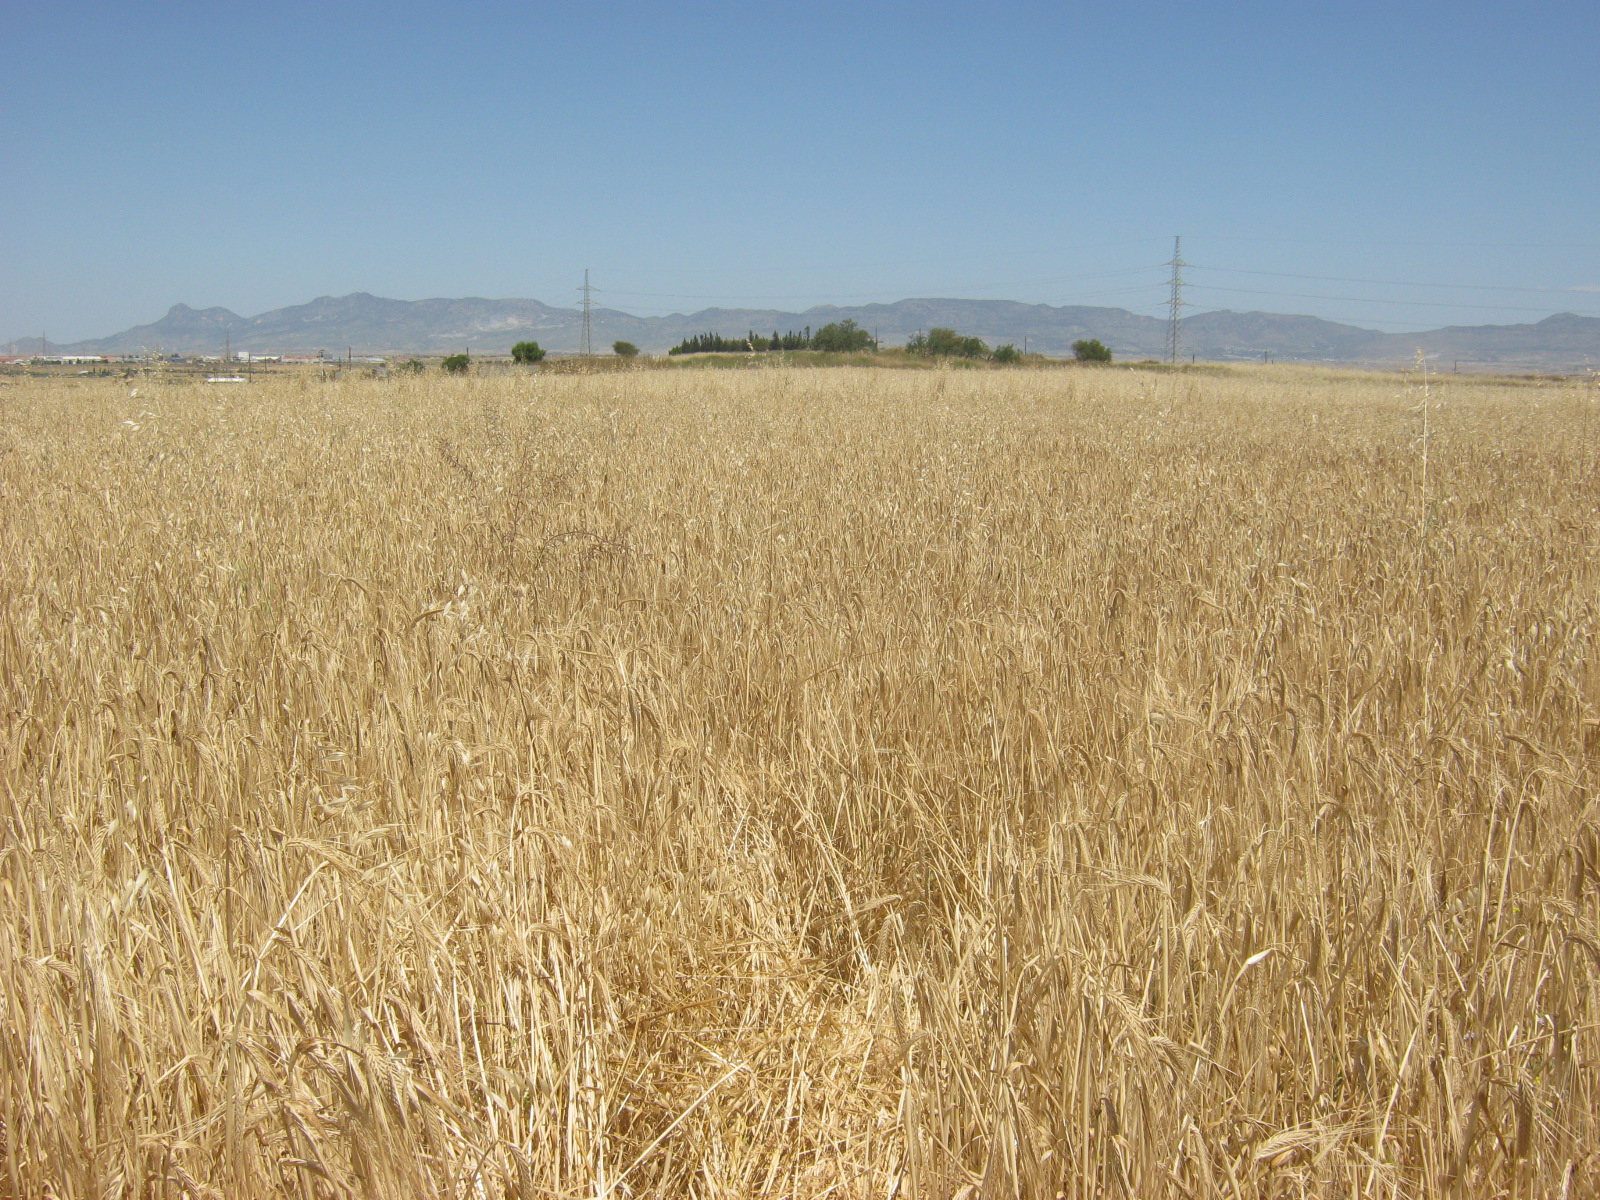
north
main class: Cropland
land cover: Mixed cereals for fodder
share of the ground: > 75 %
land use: Agriculture (excluding fallow land and kitchen gardens)
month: May
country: CY
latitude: 35.1255
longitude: 33.2431
